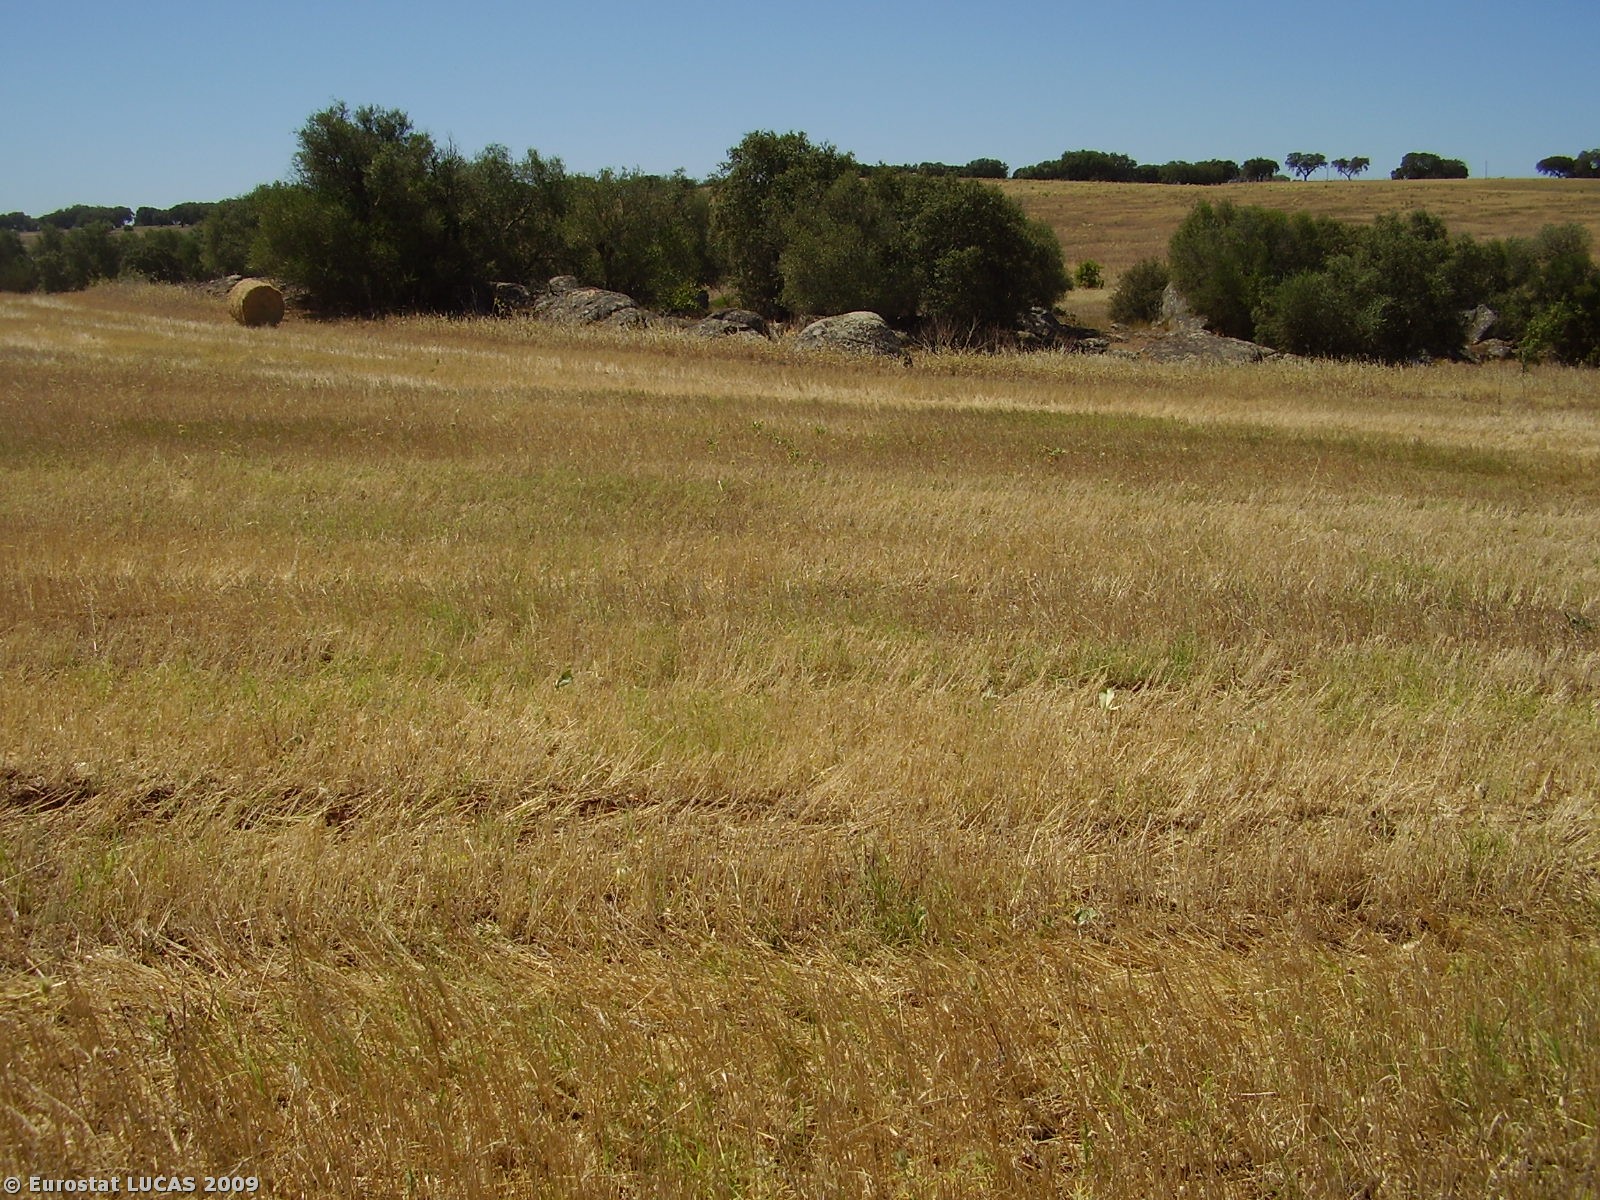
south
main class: Cropland
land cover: Common wheat
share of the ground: > 75 %
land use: Agriculture (excluding fallow land and kitchen gardens)
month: July
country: PT
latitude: 38.8828
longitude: -7.9017
